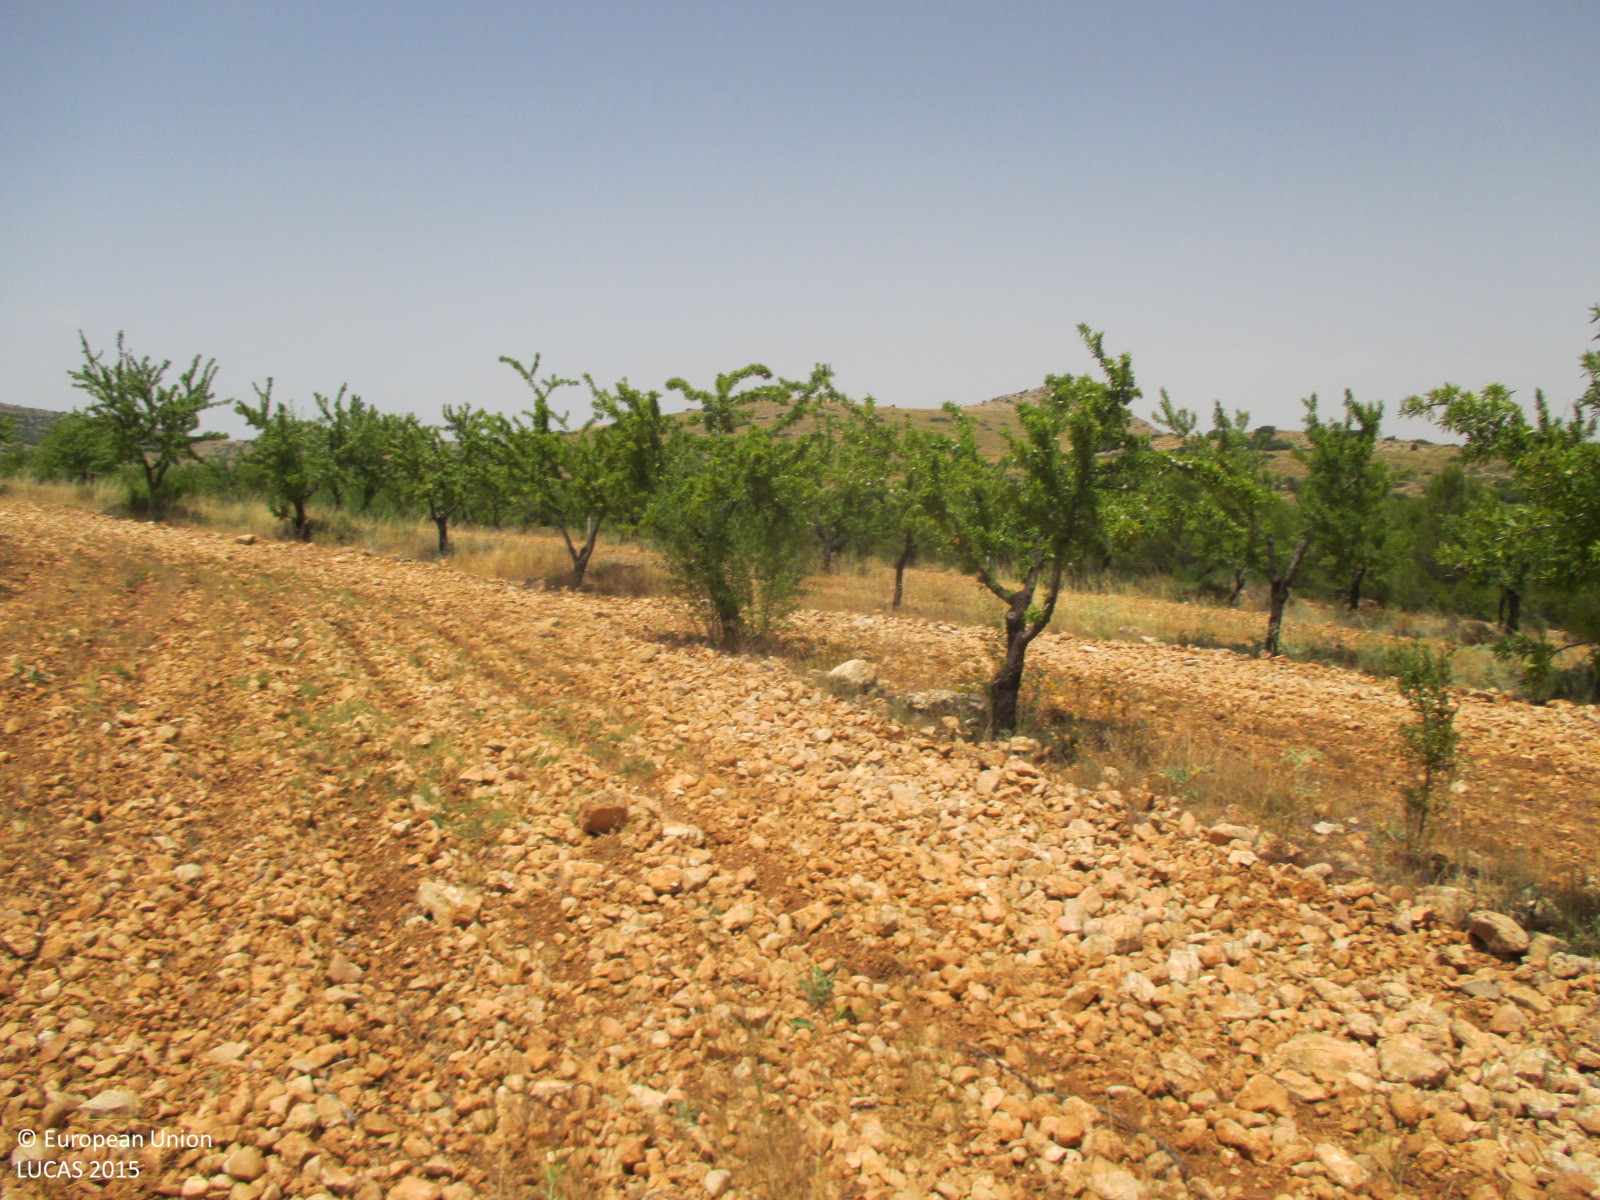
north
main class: Cropland
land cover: Nuts trees
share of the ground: 10 - 25 %
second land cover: Other bare soil
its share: > 75 %
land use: Agriculture (excluding fallow land and kitchen gardens)
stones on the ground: < 10 %
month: June
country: ES
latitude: 37.6596
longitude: -2.4450
